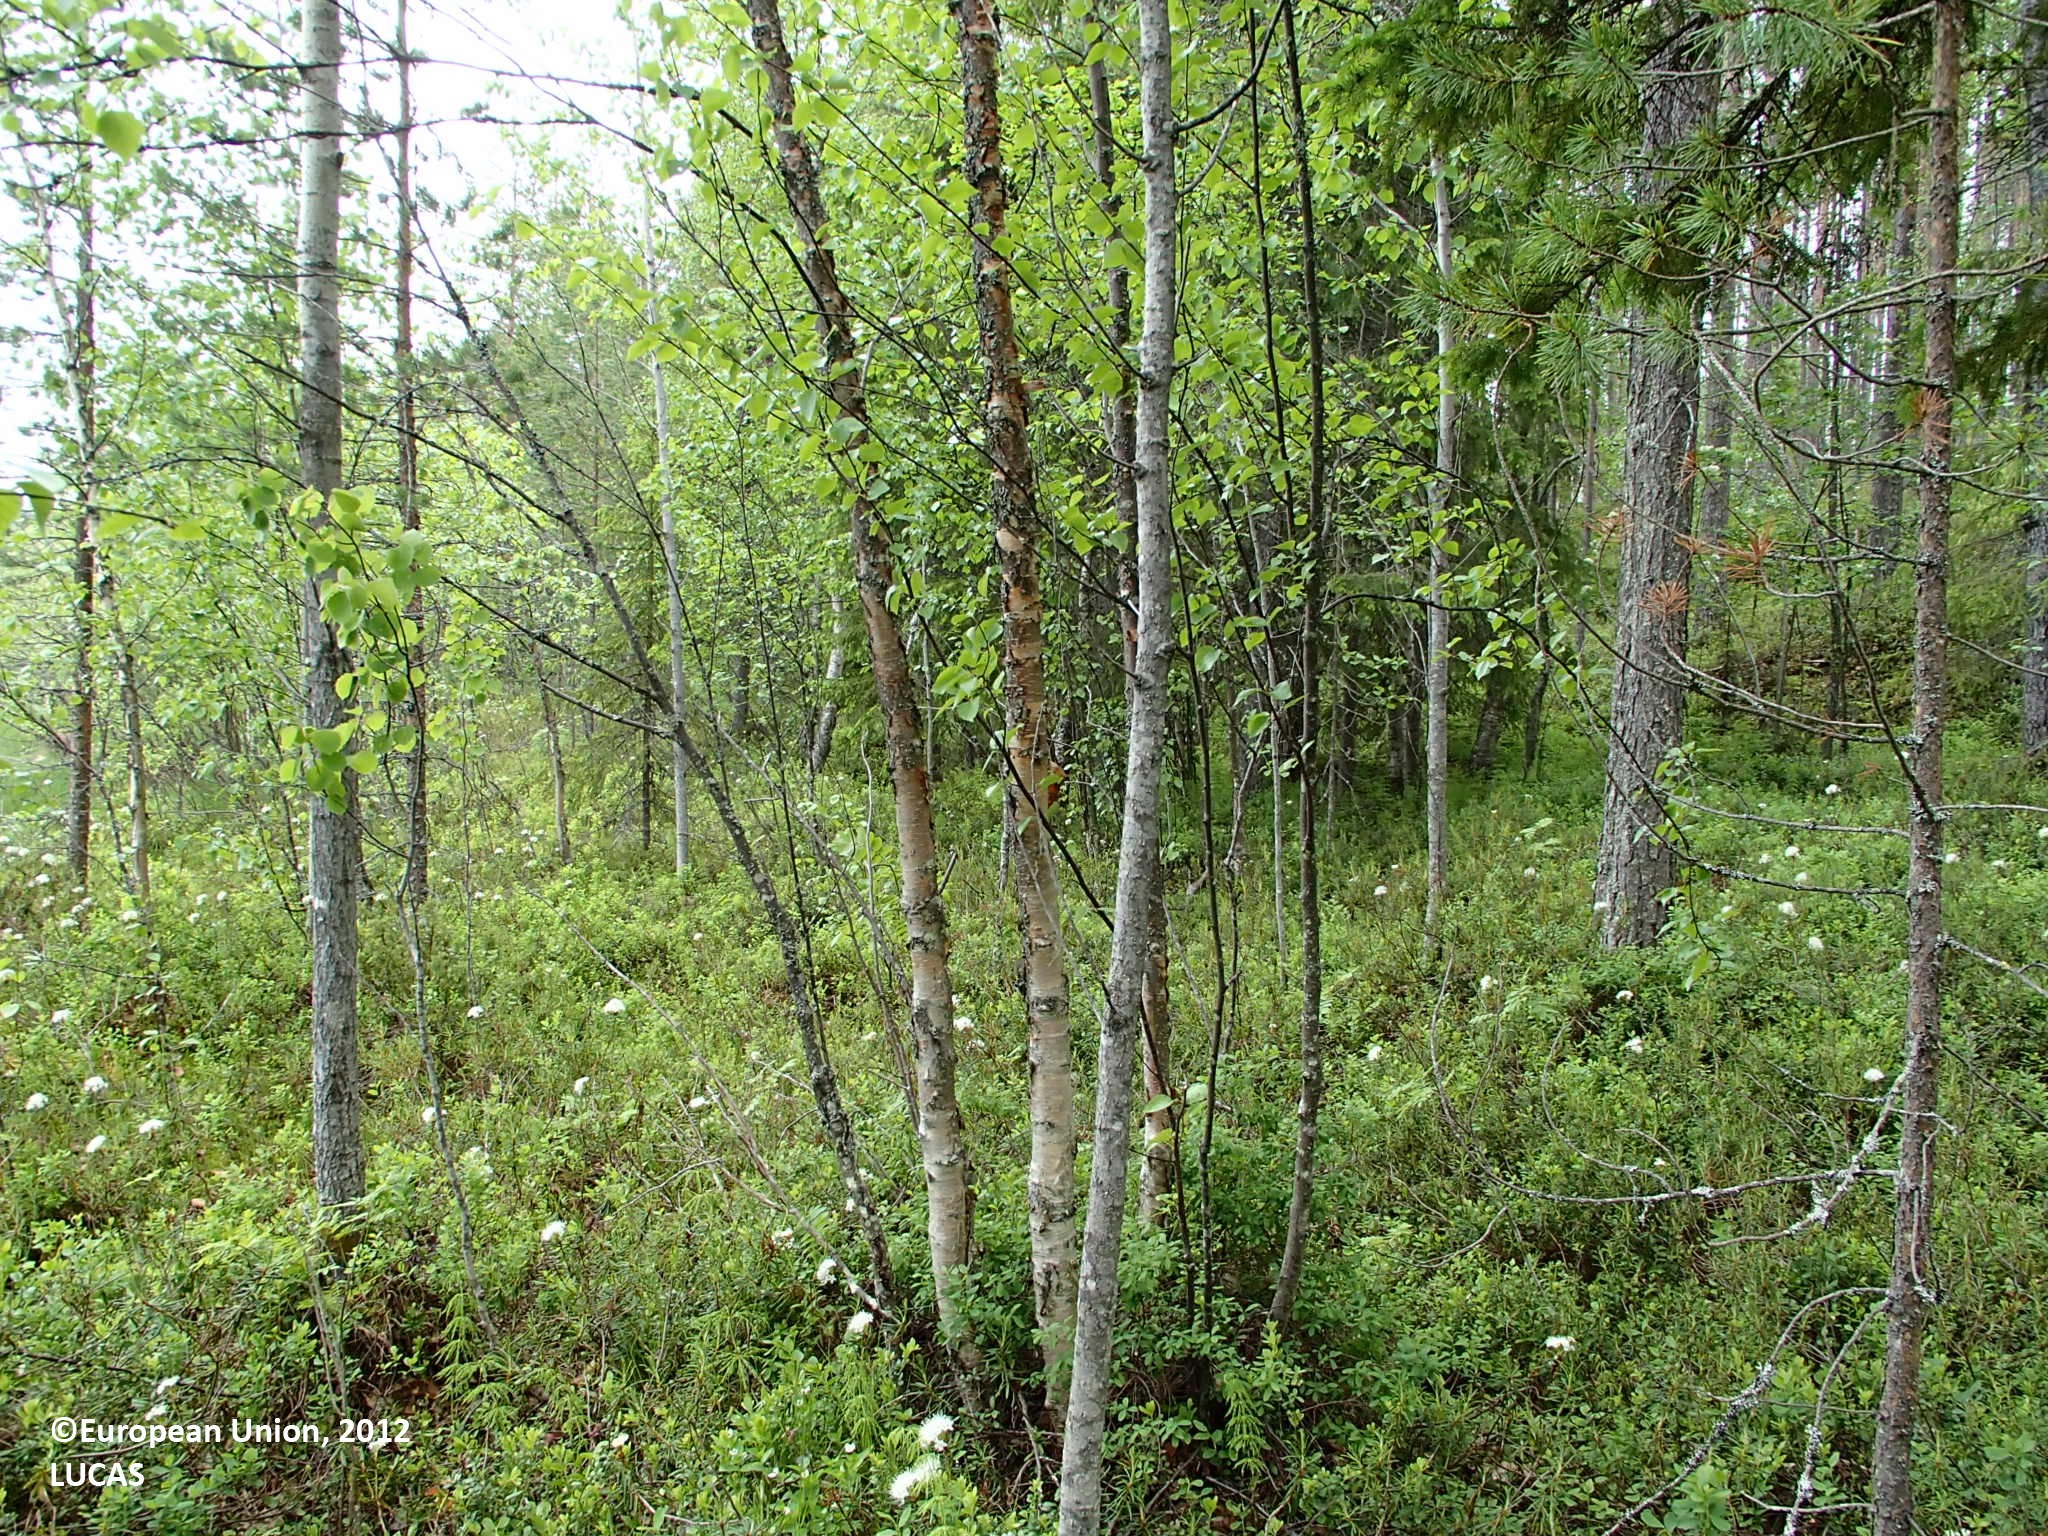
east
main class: Woodland
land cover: Pine dominated mixed woodland
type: boreal forest
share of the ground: > 75 %
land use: Forestry
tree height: > 5 m
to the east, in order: Pine dominated mixed woodland; Broadleaved woodland; Inland water bodies
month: June
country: FI
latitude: 66.5986
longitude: 27.6952
